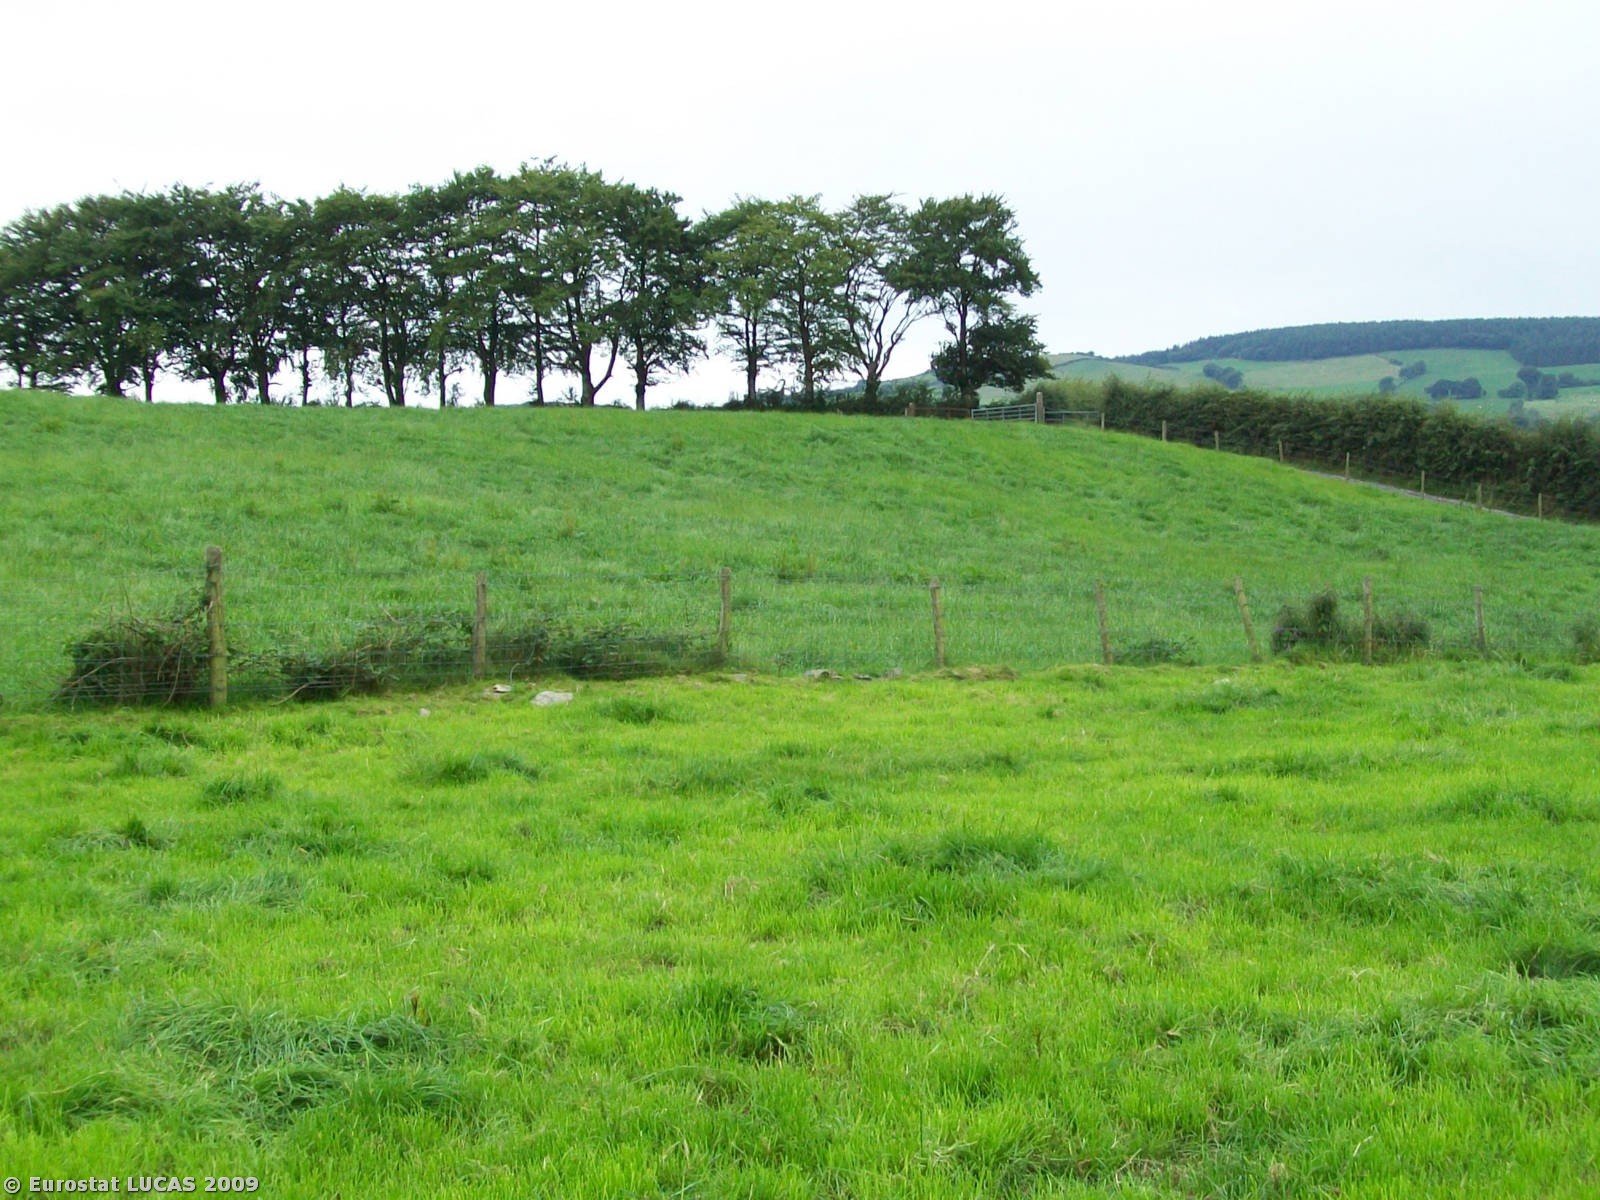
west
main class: Grassland
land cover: Grassland without tree/shrub cover
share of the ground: > 75 %
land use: Agriculture (excluding fallow land and kitchen gardens)
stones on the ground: 10 - 25 %
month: August
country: GB
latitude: 54.1712
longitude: -6.6271
